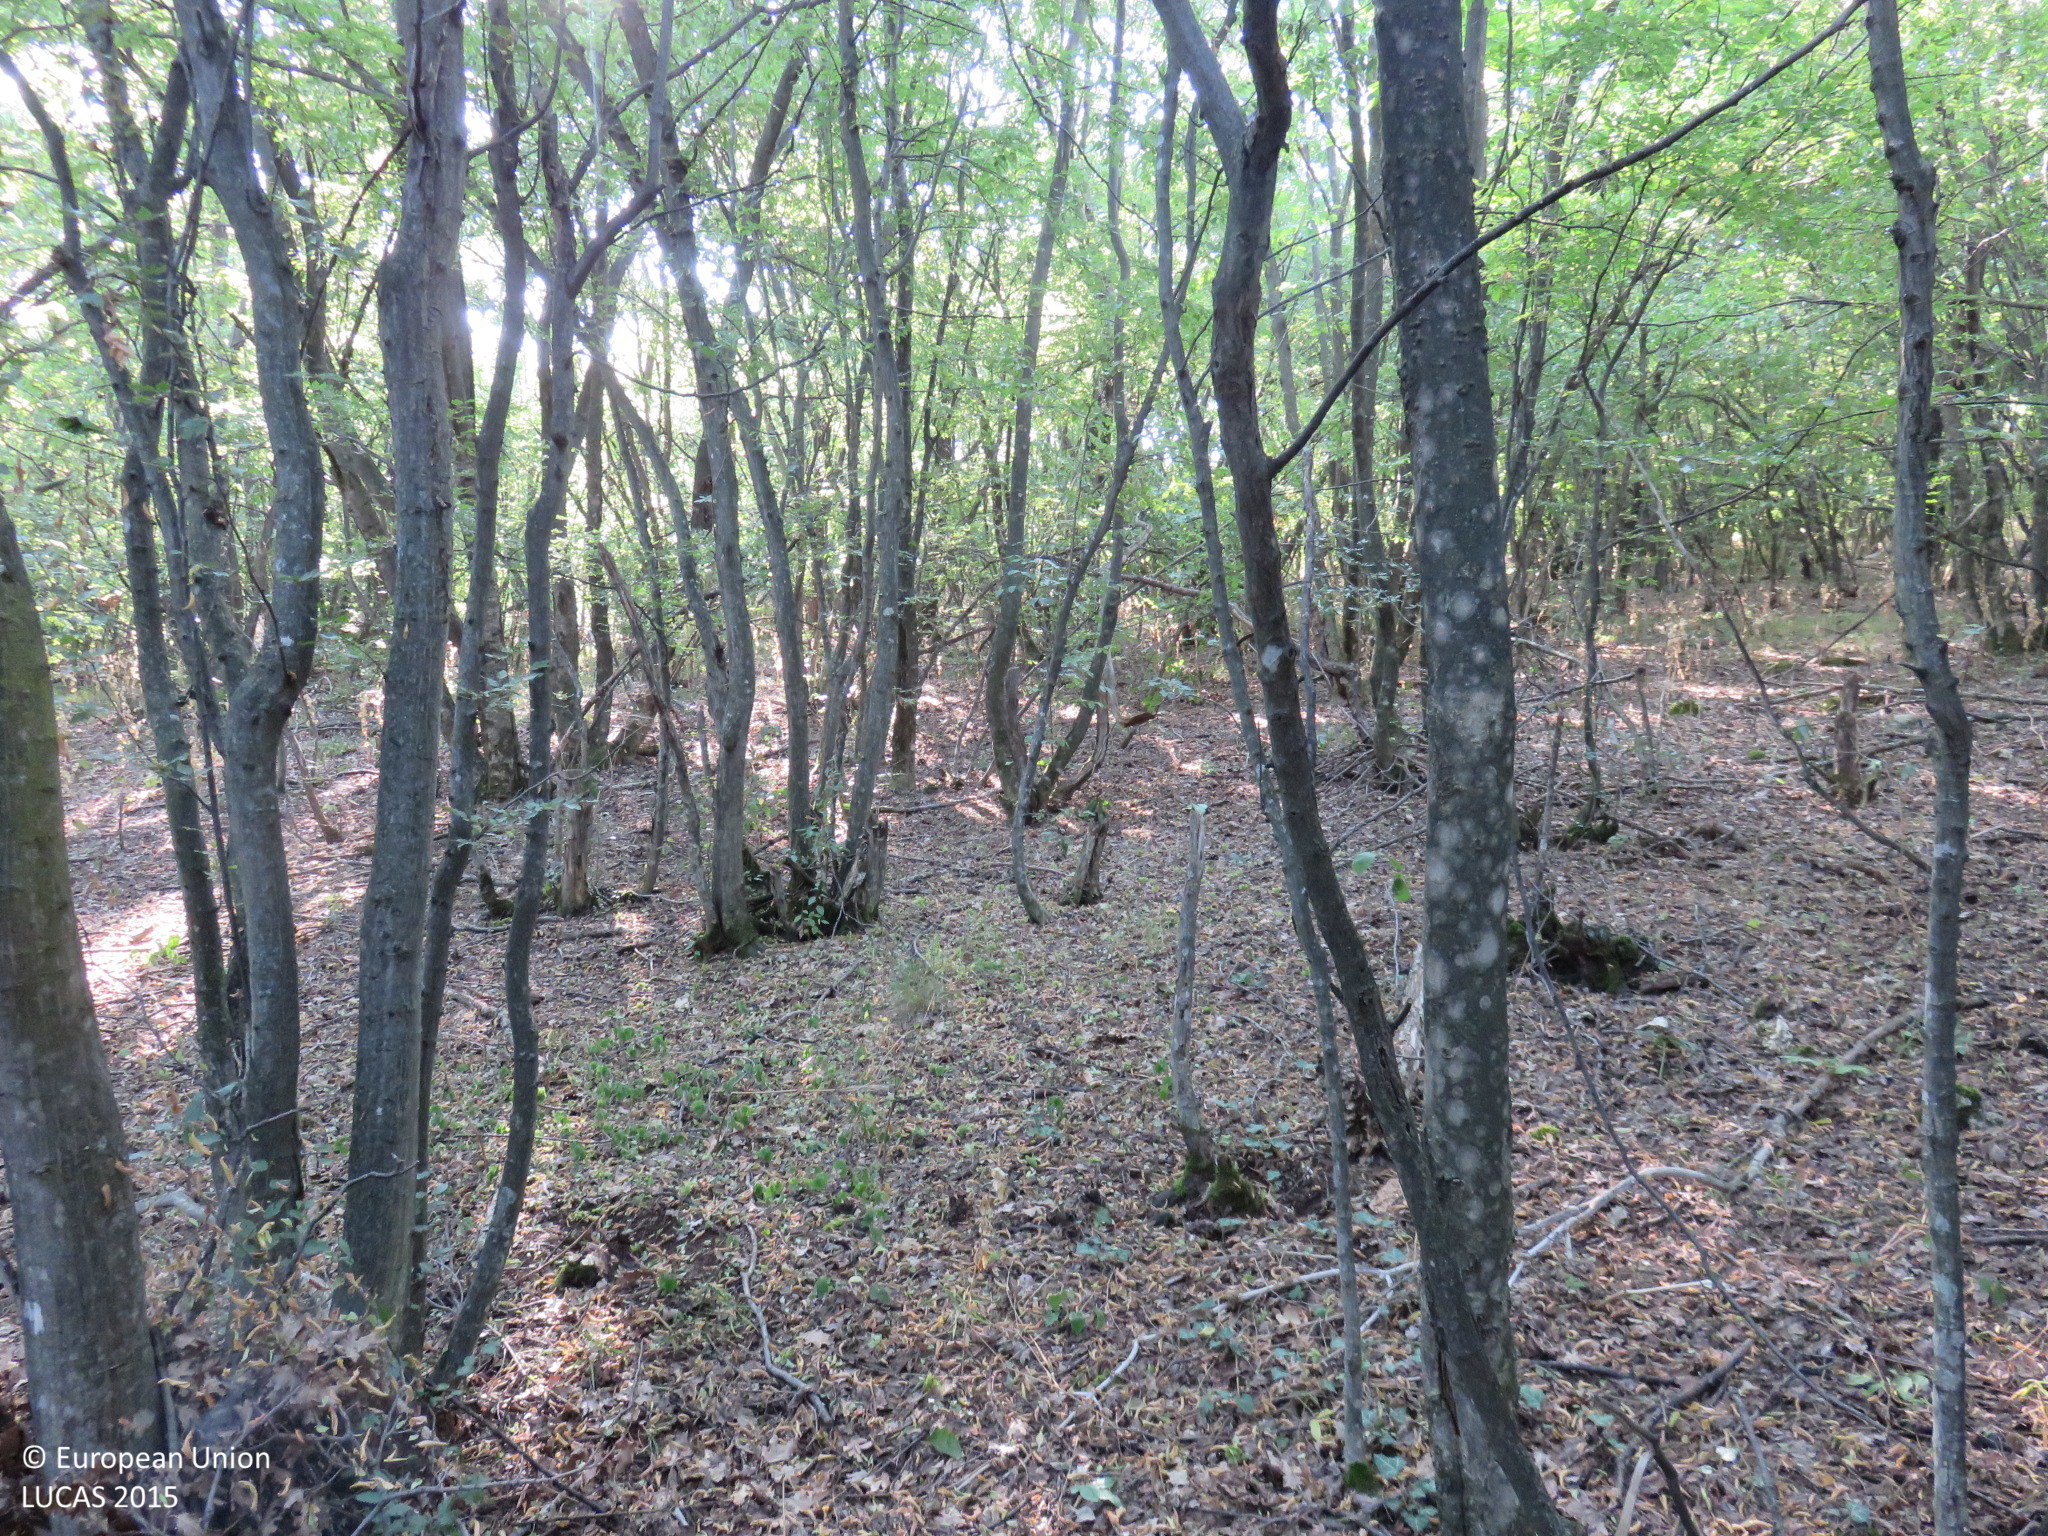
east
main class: Woodland
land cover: Broadleaved woodland
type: mesophytic deciduous forest
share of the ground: > 75 %
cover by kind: broadleaved forest trees 90 %, unconsolidated bare surface 10 %
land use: Forestry
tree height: < 5 m
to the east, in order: Broadleaved woodland; Shrubland with sparse tree cover; Grassland with sparse tree/shrub cover; Broadleaved woodland
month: July
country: BG
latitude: 43.2267
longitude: 25.0532
